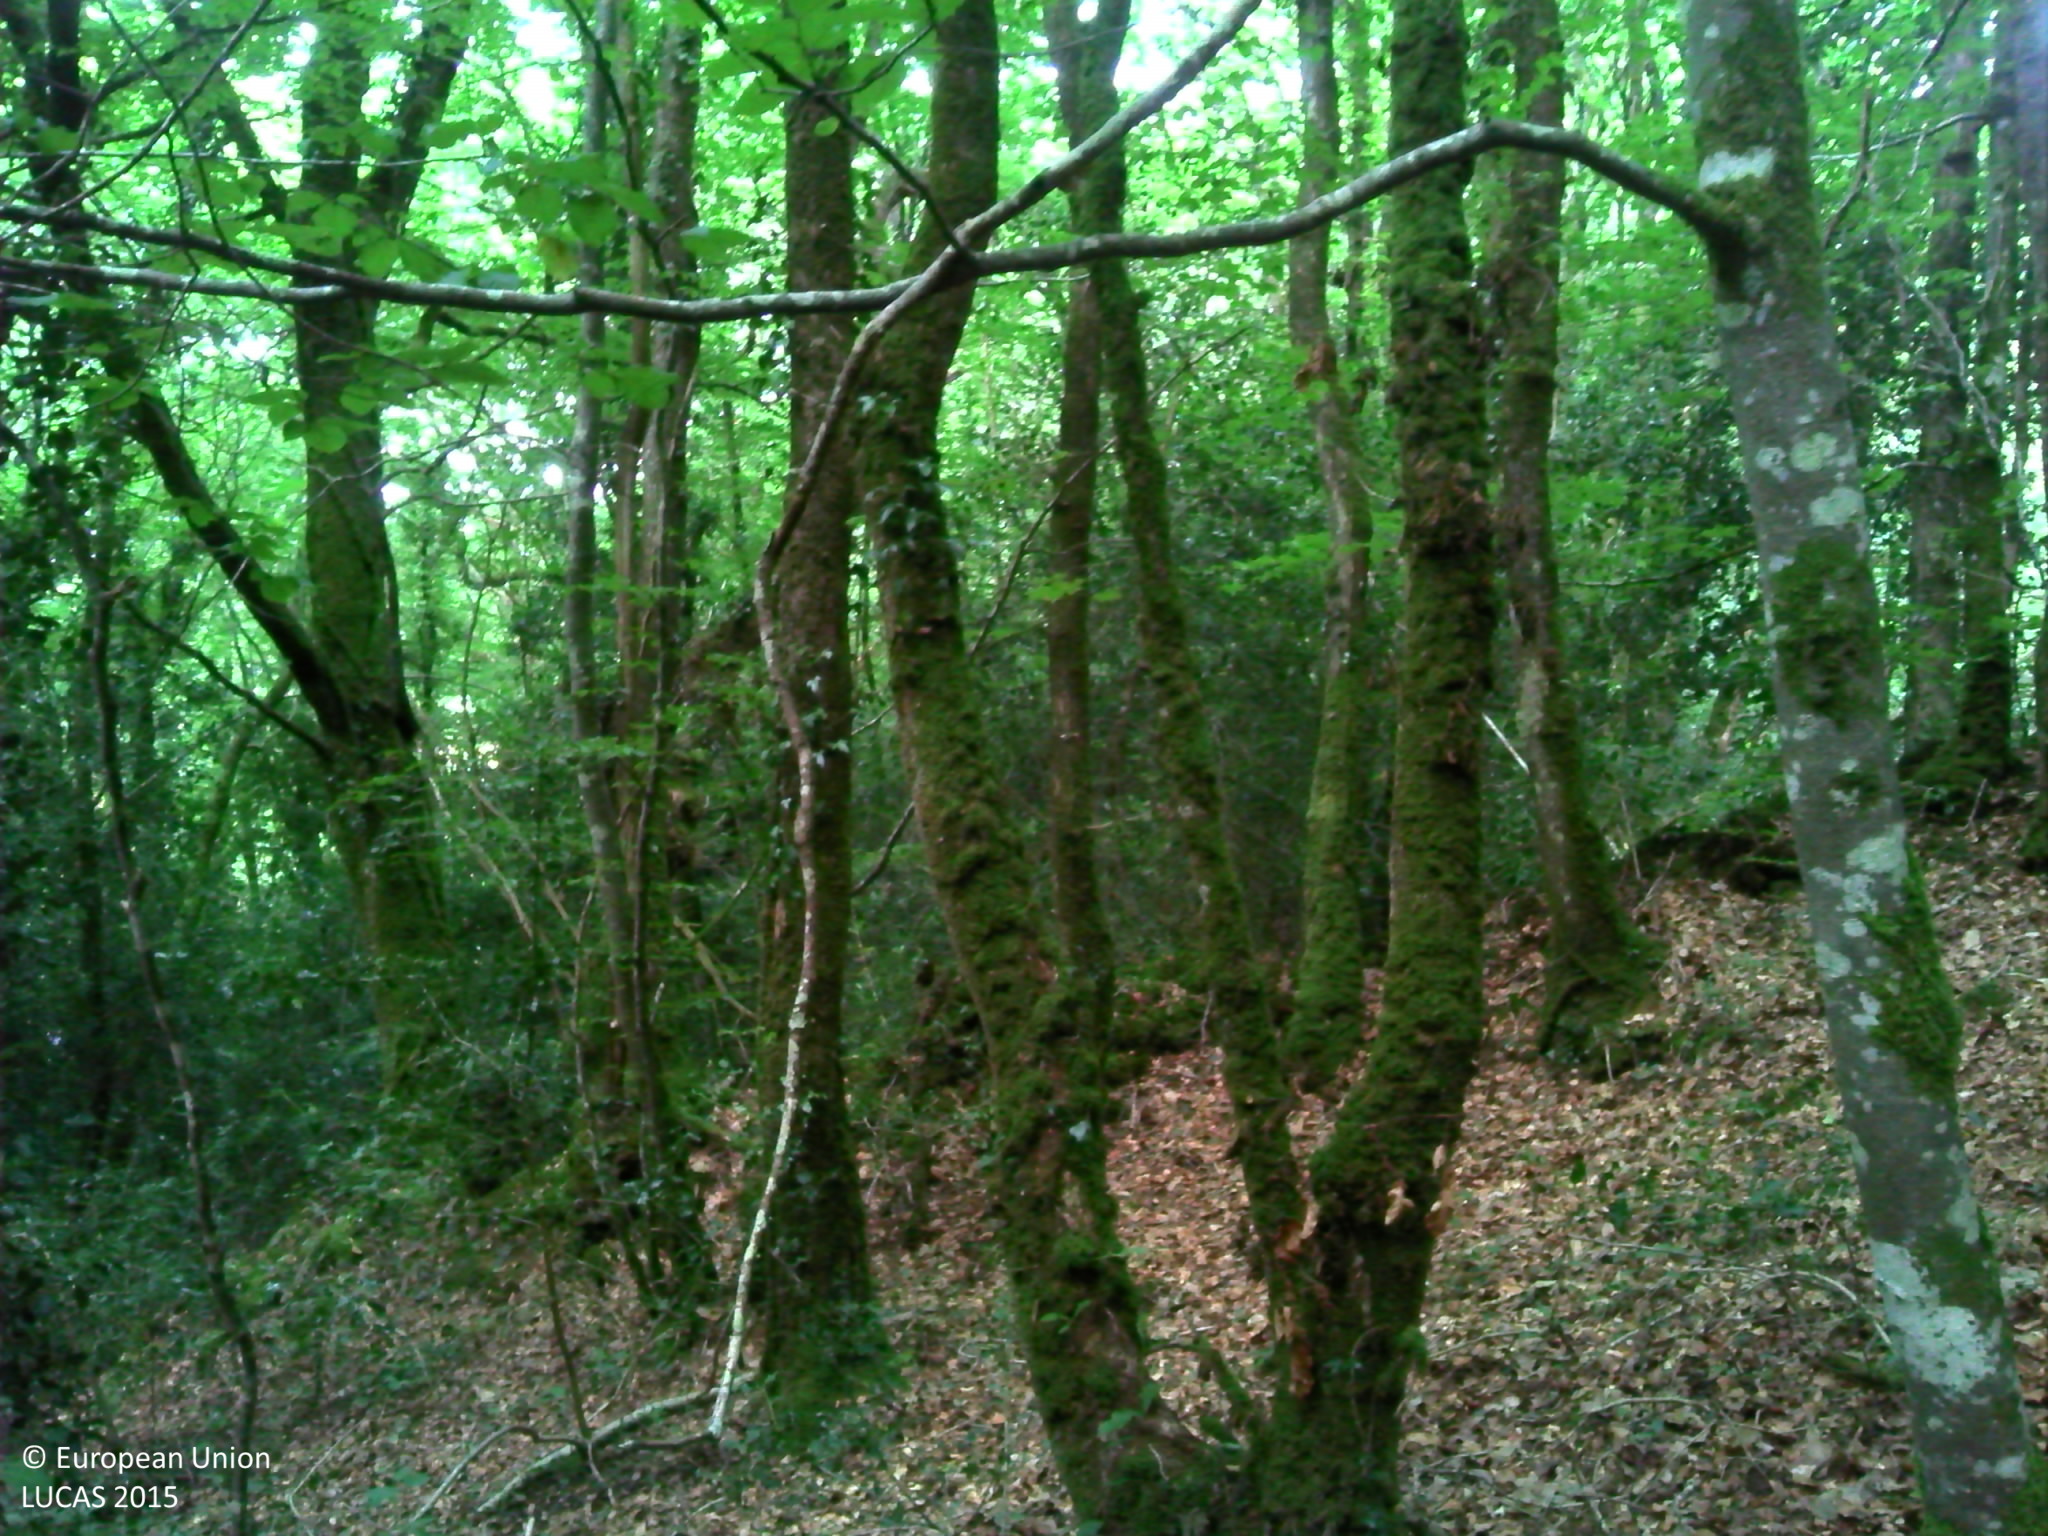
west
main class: Woodland
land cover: Broadleaved woodland
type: acidophilous oak and oak-birch forest
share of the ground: > 75 %
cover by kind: broadleaved forest trees 80 %, shrubs 10 %, herbaceous plants 10 %
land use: Forestry
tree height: > 5 m
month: August
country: FR
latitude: 48.3499
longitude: -3.3949
